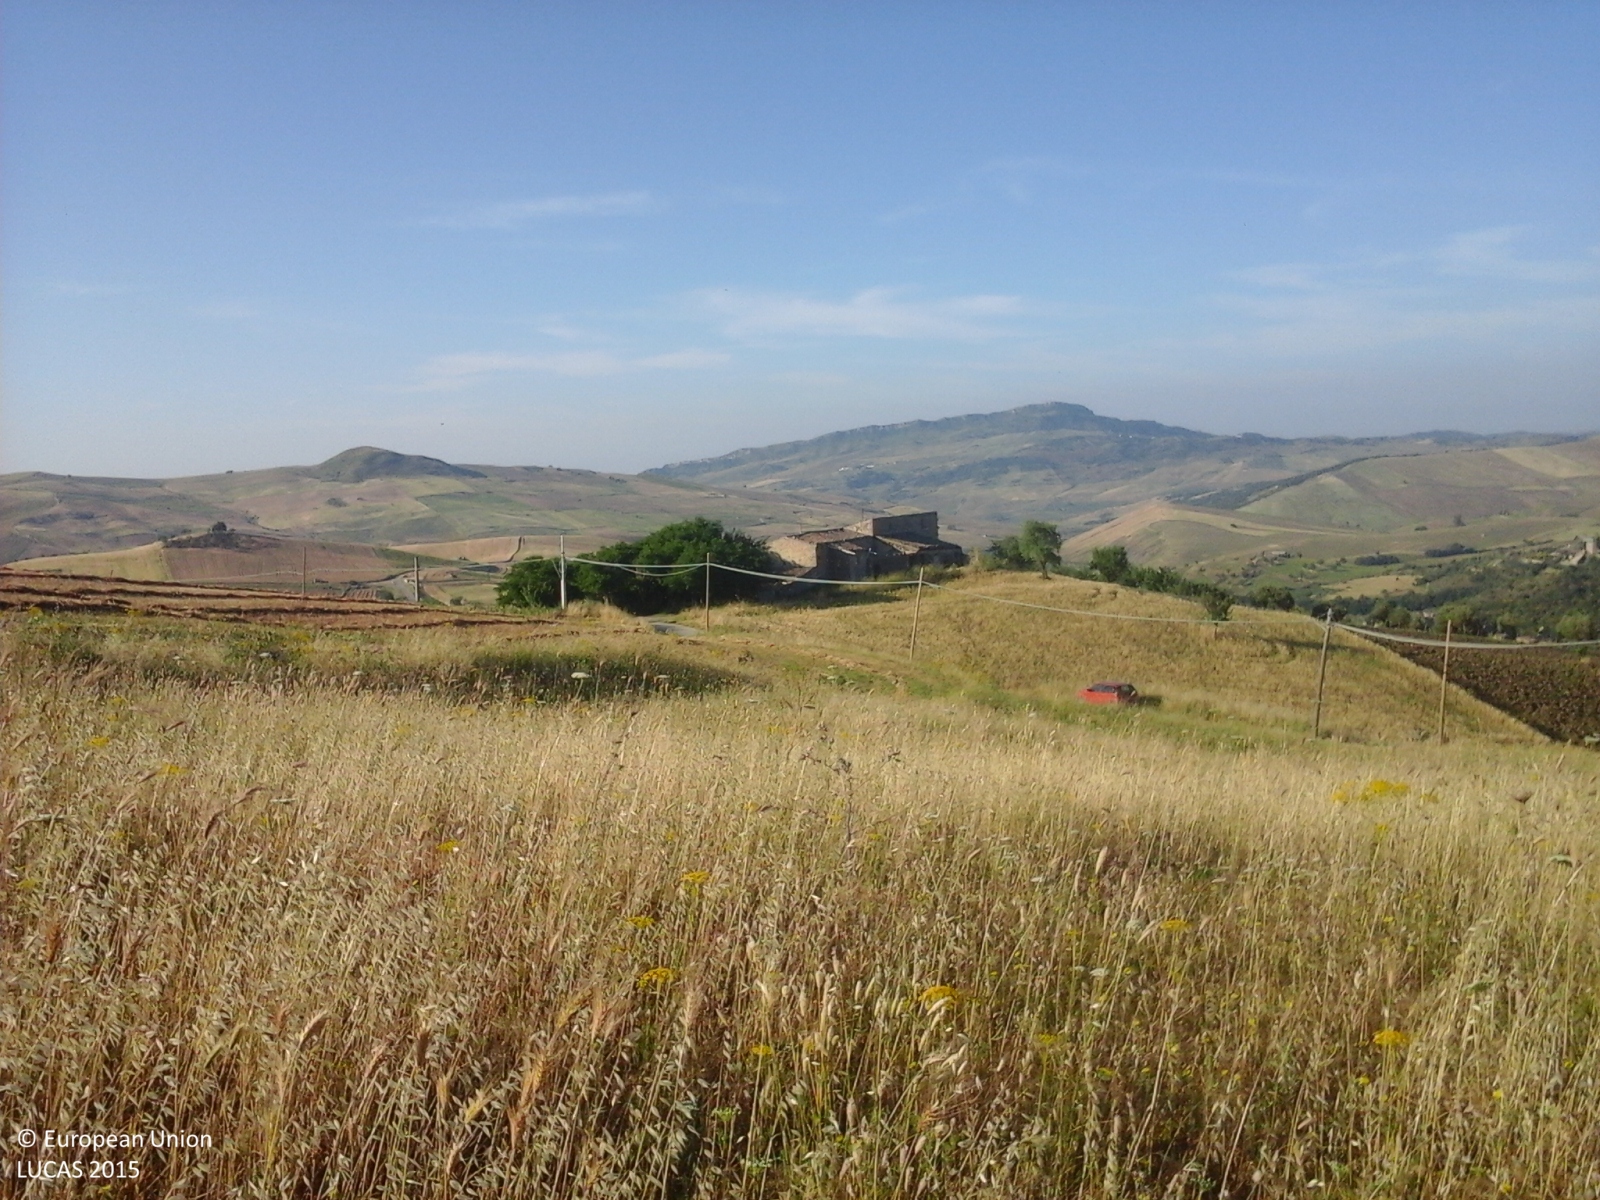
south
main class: Grassland
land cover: Grassland without tree/shrub cover
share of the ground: > 75 %
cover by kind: herbaceous plants 100 %
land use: Agriculture (excluding fallow land and kitchen gardens)
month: June
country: IT
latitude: 37.7666
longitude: 14.1365
